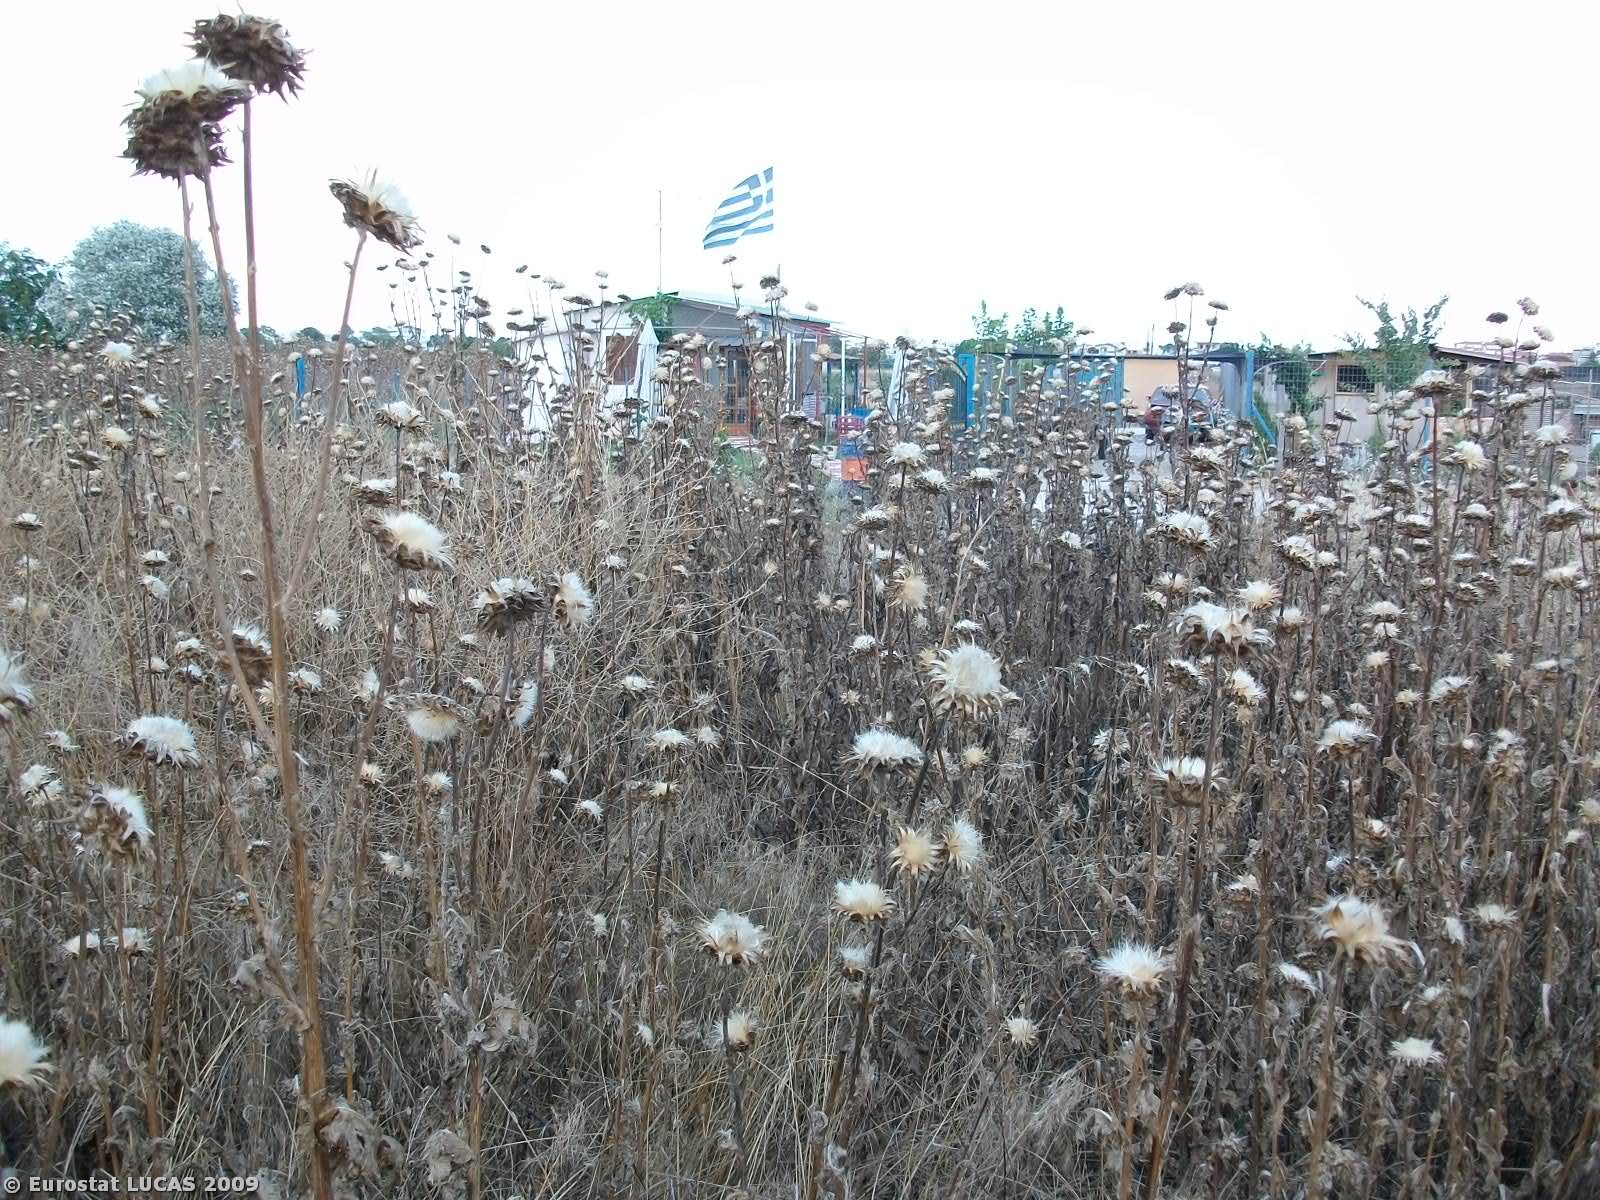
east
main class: Grassland
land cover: Spontaneously vegetated surfaces
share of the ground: > 75 %
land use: Fallow land
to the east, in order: Spontaneously vegetated surfaces; Paved roads, cycling and walking lanes; Fences; Artificial constructions in urban areas; Fences; Grassland without tree/shrub cover; Paved roads, cycling and walking lanes; Durum wheat; Fences; Durum wheat
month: June
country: GR
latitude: 39.6569
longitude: 22.4262
